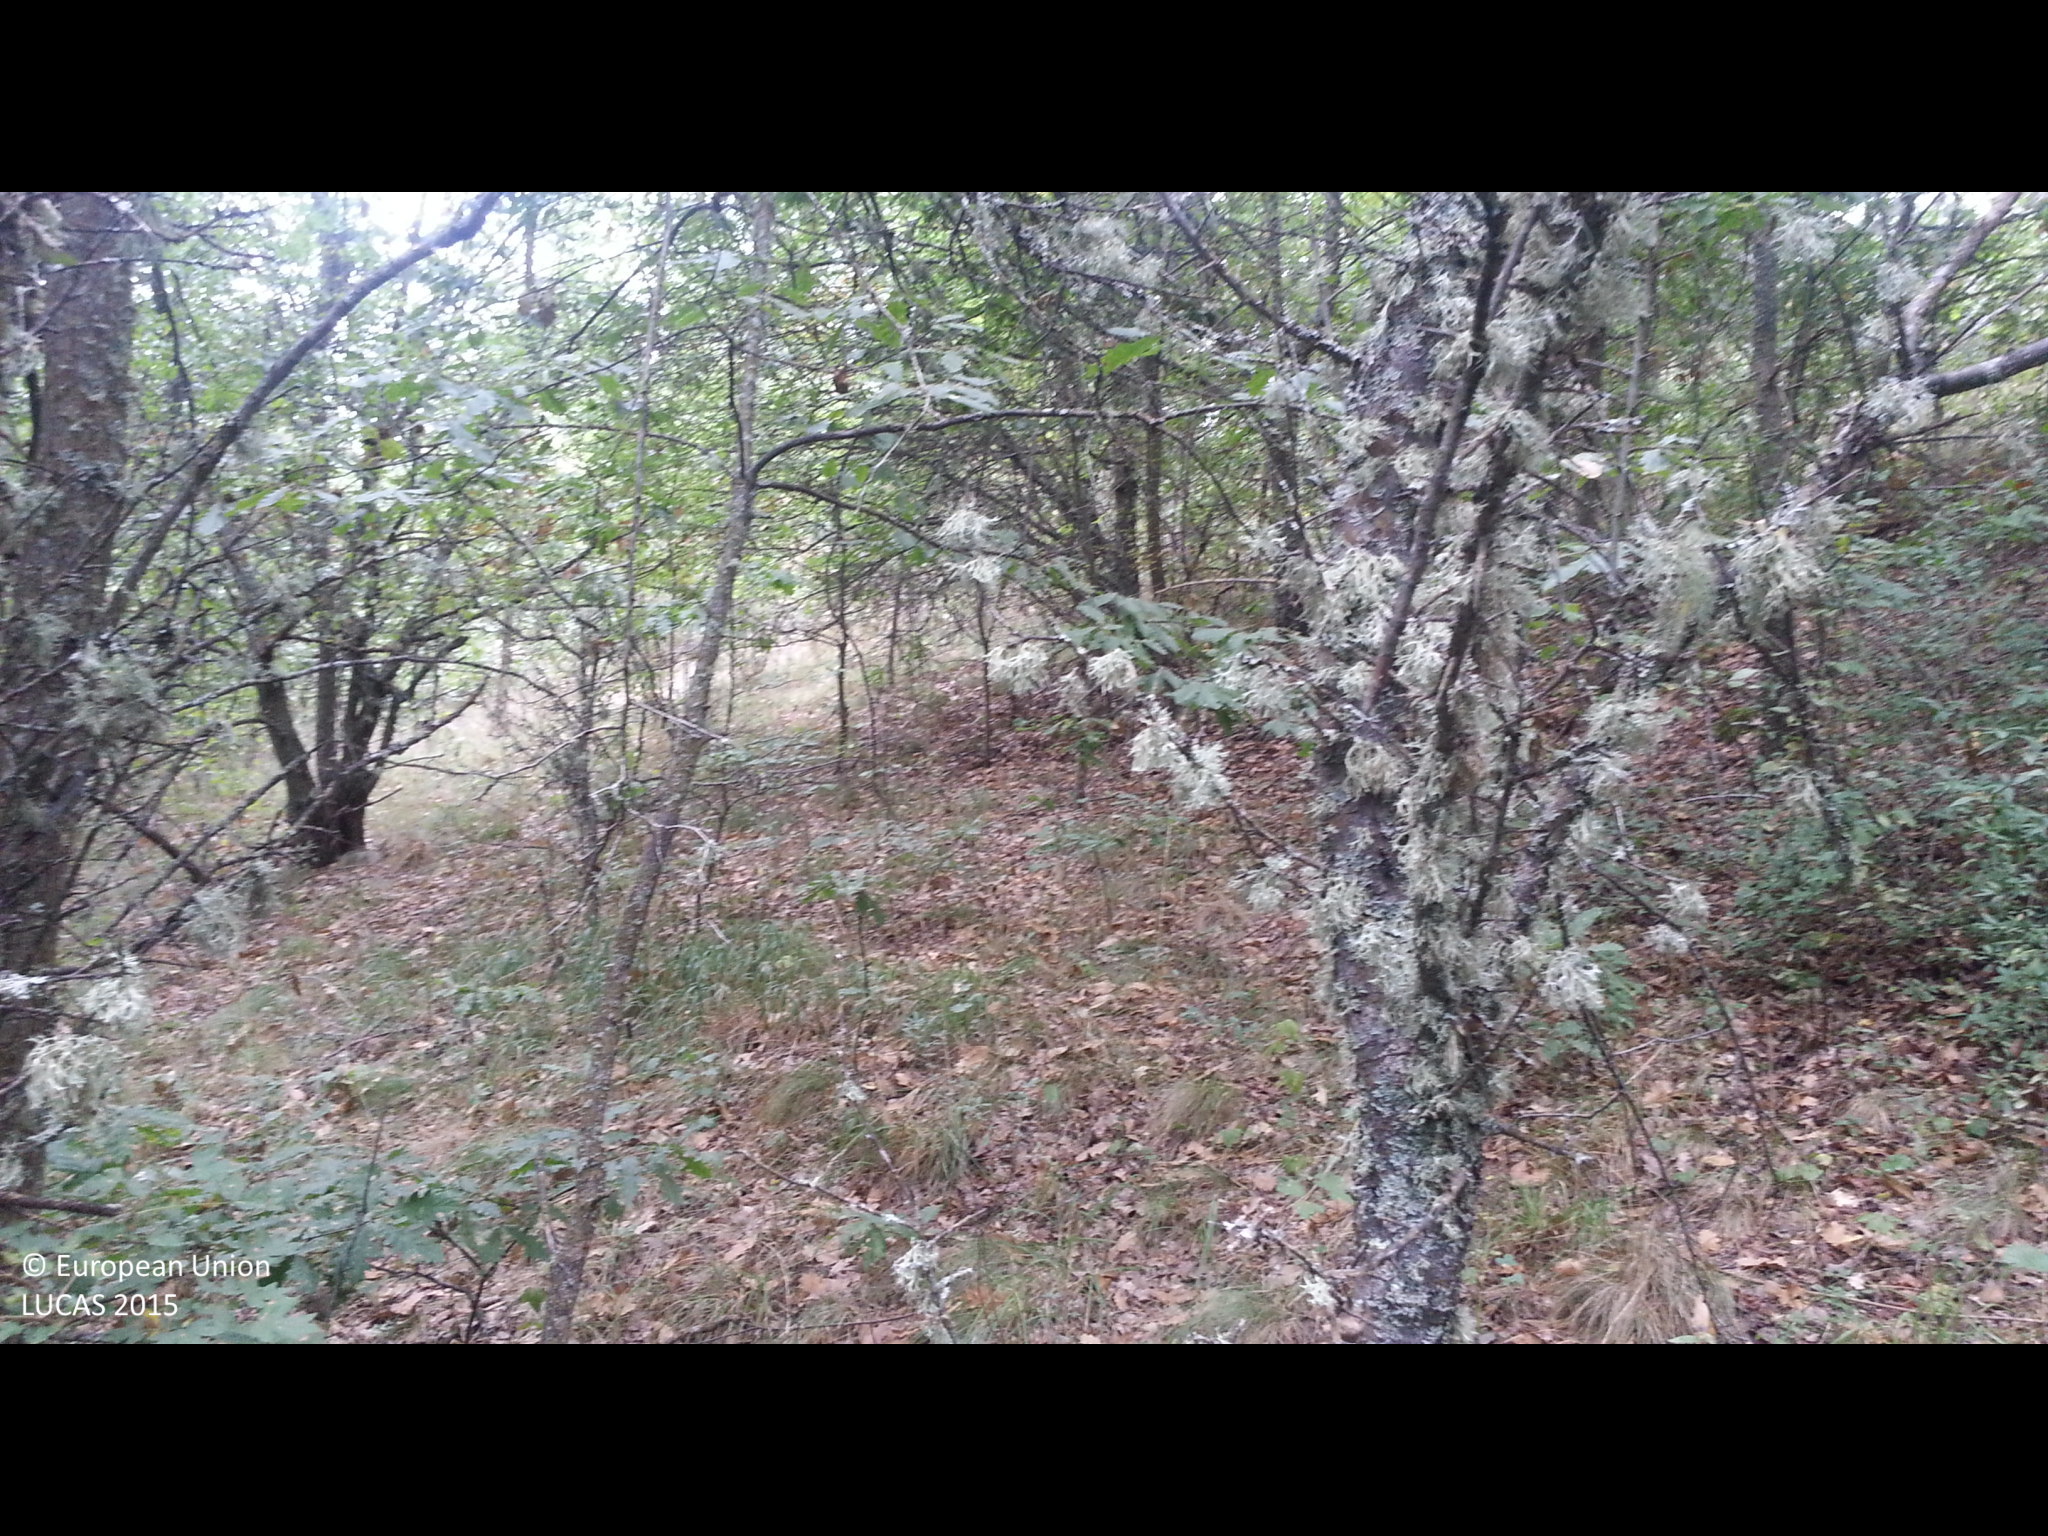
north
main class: Woodland
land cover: Broadleaved woodland
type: mesophytic deciduous forest
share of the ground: > 75 %
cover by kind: broadleaved forest trees 90 %, shrubs 10 %
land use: Forestry
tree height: > 5 m
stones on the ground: < 10 %
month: September
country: BG
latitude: 42.3643
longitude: 22.5393
